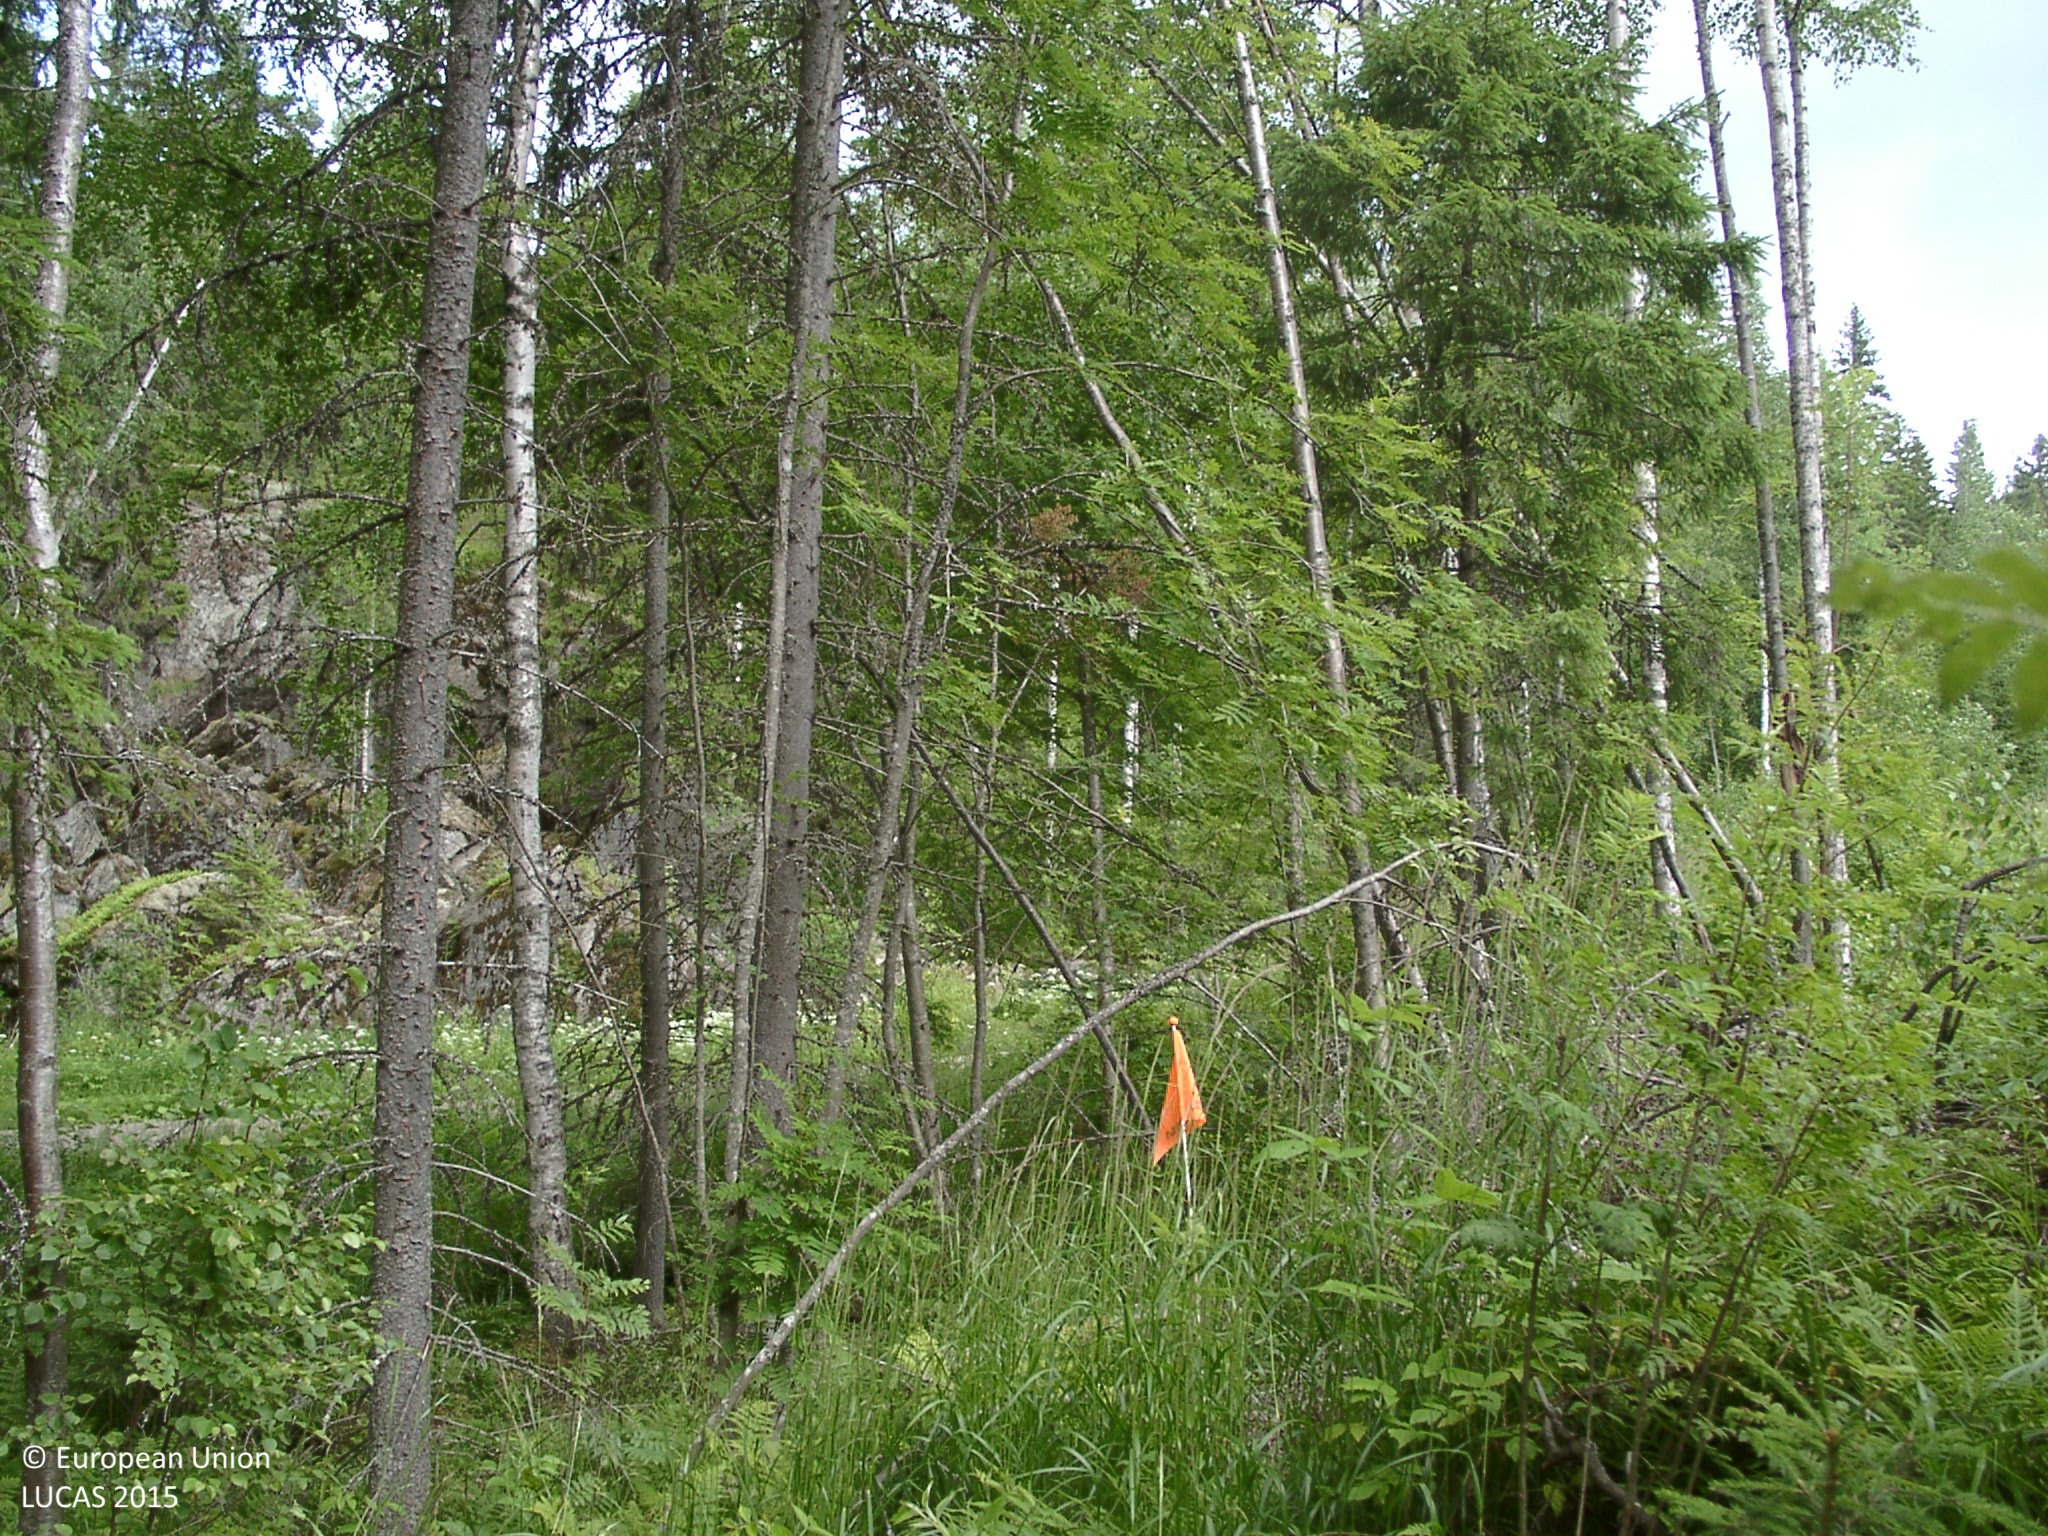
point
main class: Woodland
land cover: Spruce dominated mixed woodland
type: boreal forest
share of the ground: > 75 %
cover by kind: coniferous forest trees 40 %, broadleaved forest trees 35 %, shrubs 15 %, herbaceous plants 10 %
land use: Forestry
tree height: > 5 m
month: July
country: FI
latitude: 61.6501
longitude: 25.1959
